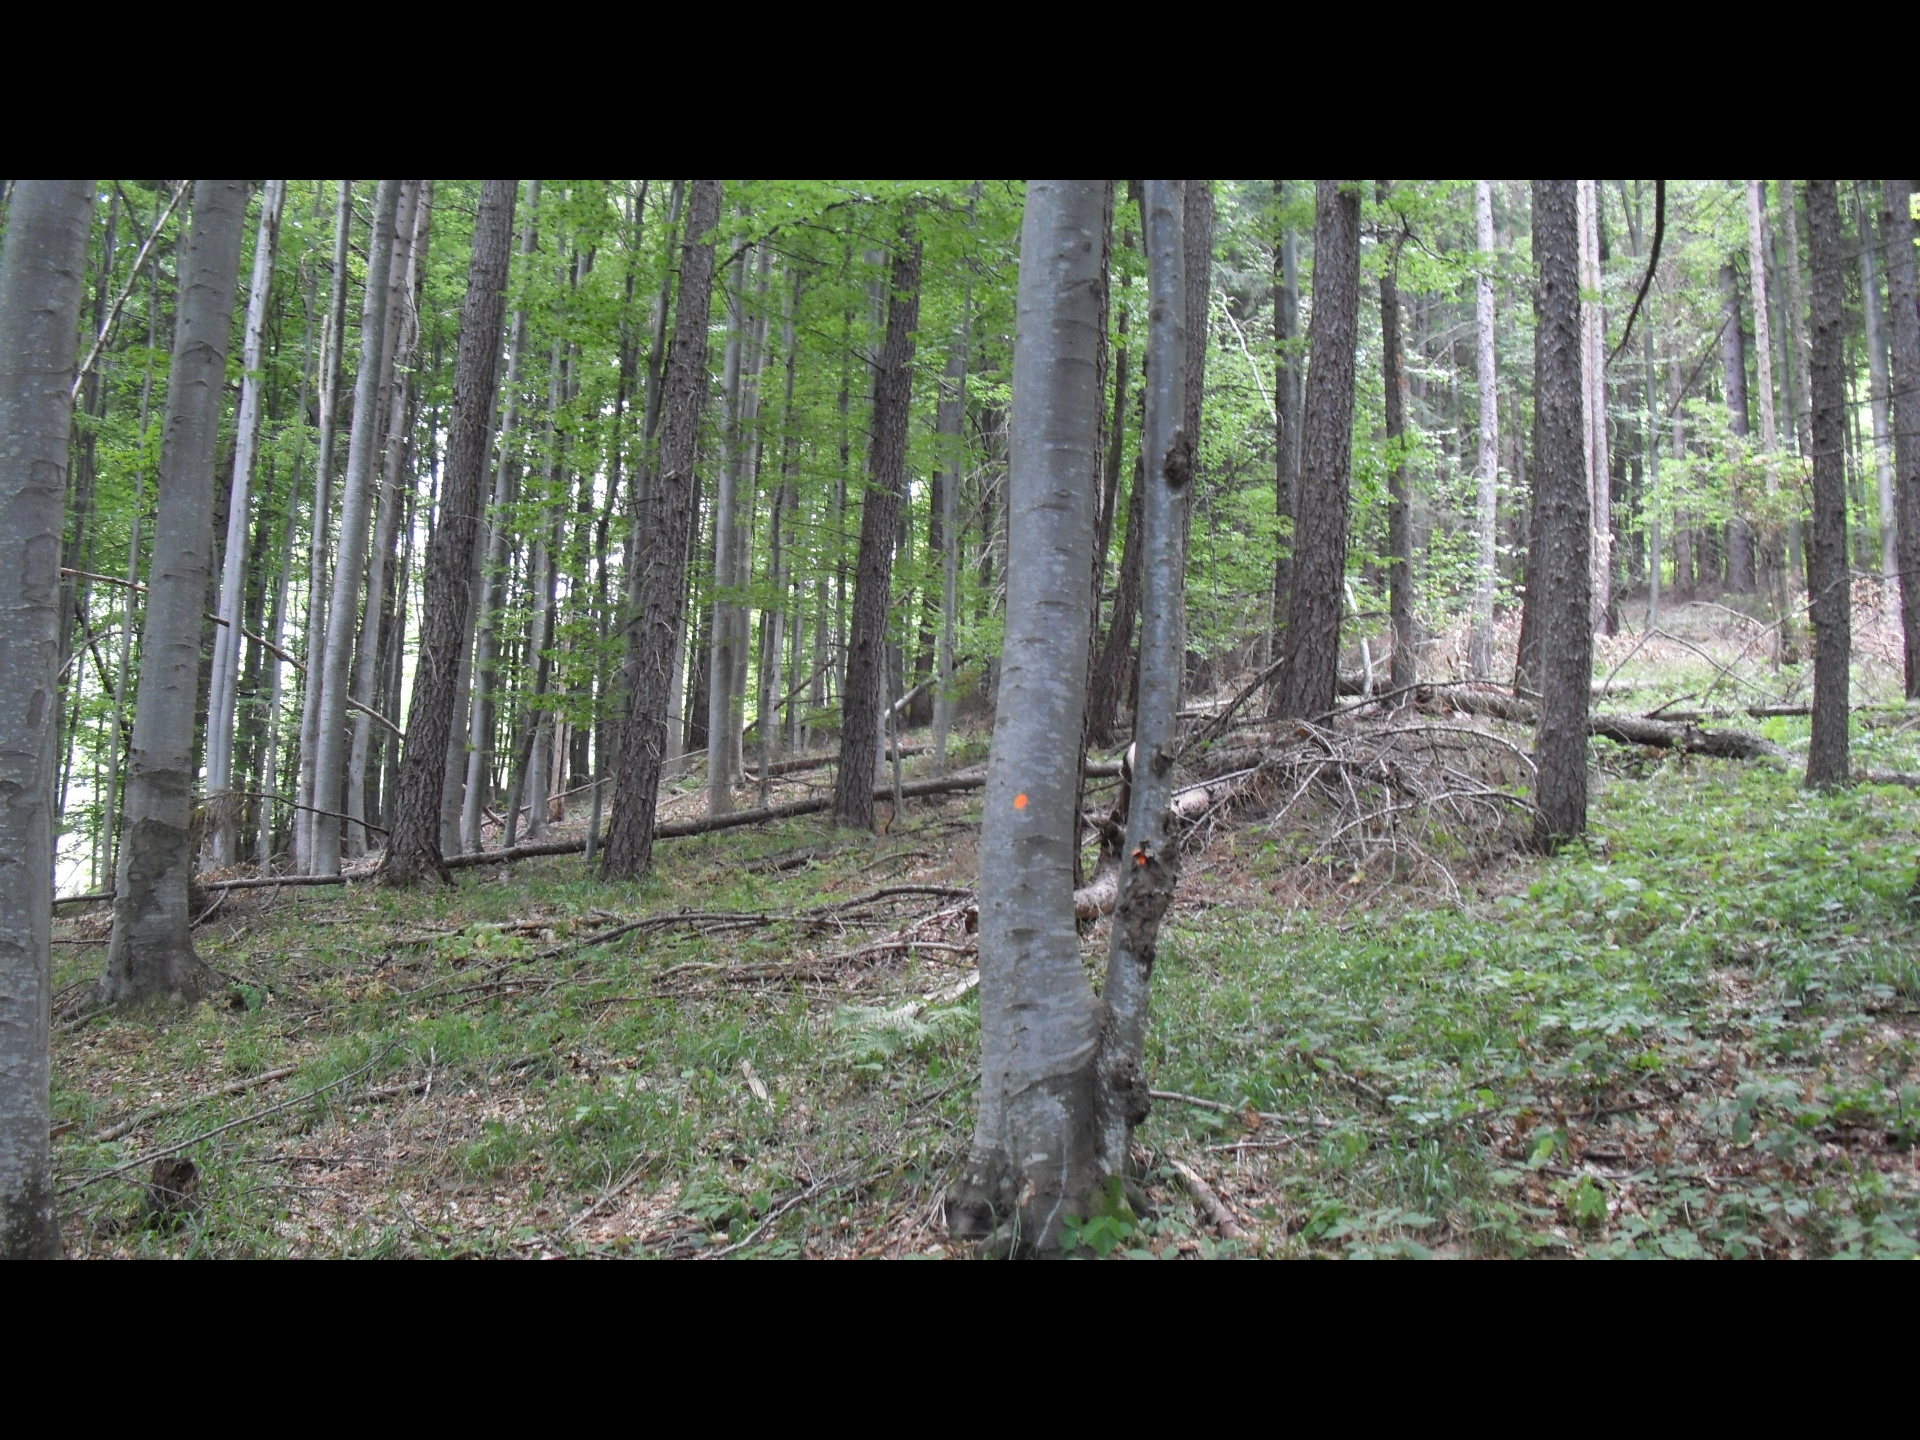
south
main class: Woodland
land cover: Other mixed woodland
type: hemiboreal forest and nemoral coniferous forest and mixed broadleaved-coniferous forest
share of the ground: > 75 %
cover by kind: coniferous forest trees 50 %, broadleaved forest trees 40 %, herbaceous plants 10 %
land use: Forestry
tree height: > 5 m
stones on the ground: < 10 %
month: August
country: BG
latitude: 43.1437
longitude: 23.1554
